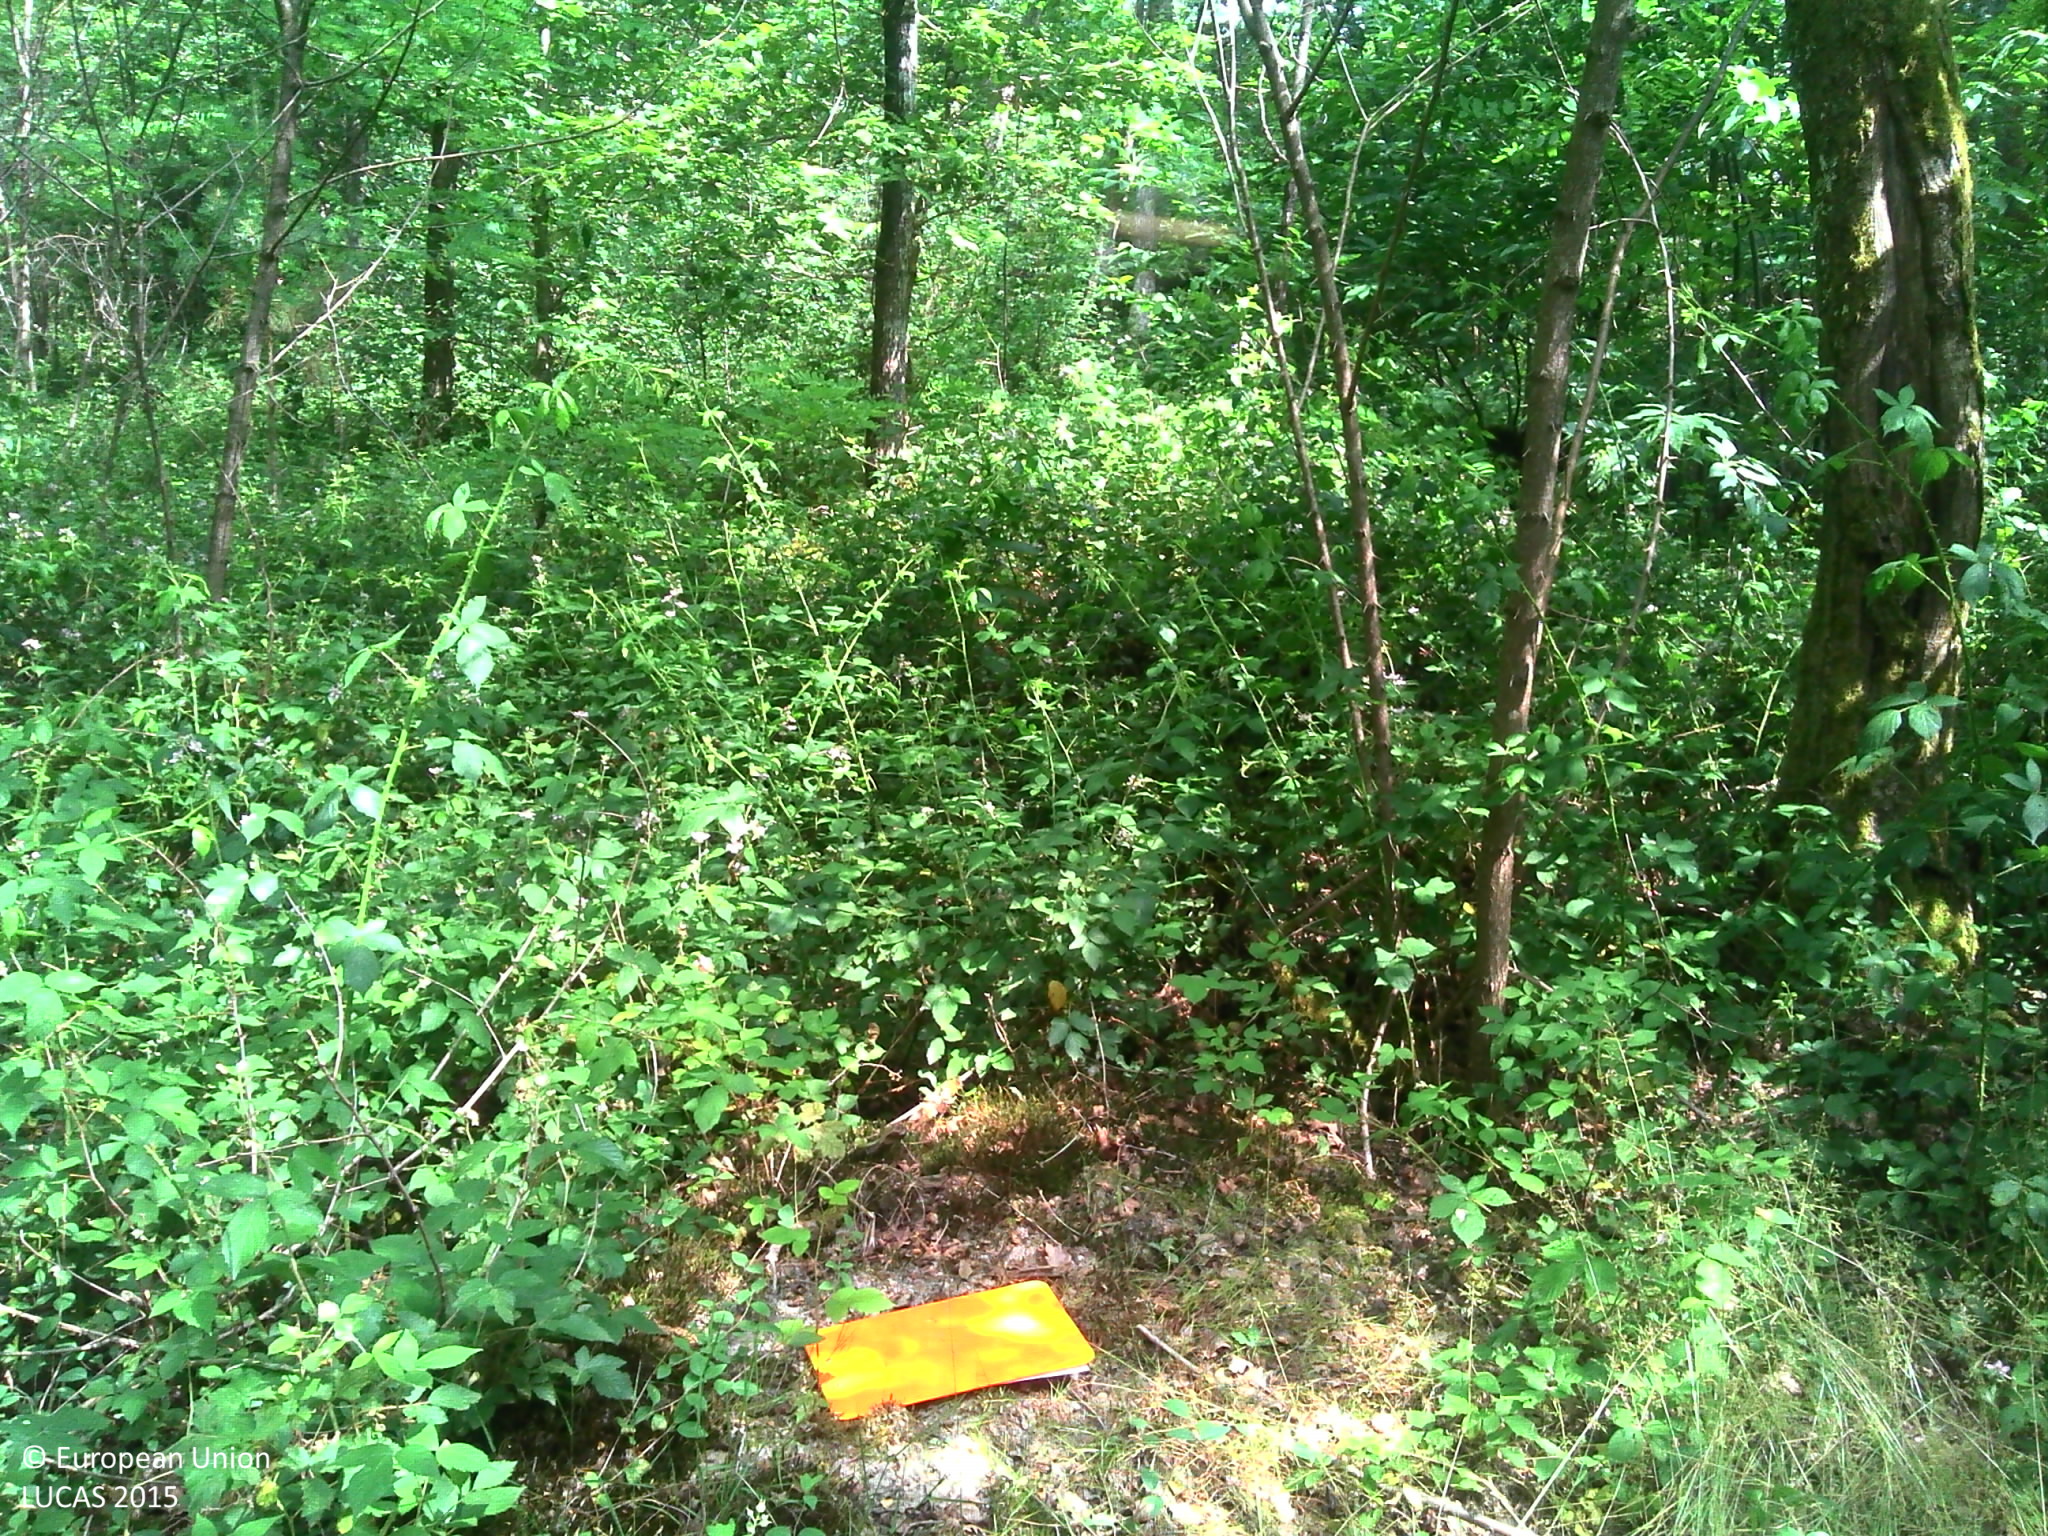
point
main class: Woodland
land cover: Broadleaved woodland
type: mesophytic deciduous forest
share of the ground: > 75 %
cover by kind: herbaceous plants 50 %, broadleaved forest trees 30 %, lichens and mosses 20 %
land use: Forestry
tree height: > 5 m
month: June
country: FR
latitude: 47.6264
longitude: 2.0180
